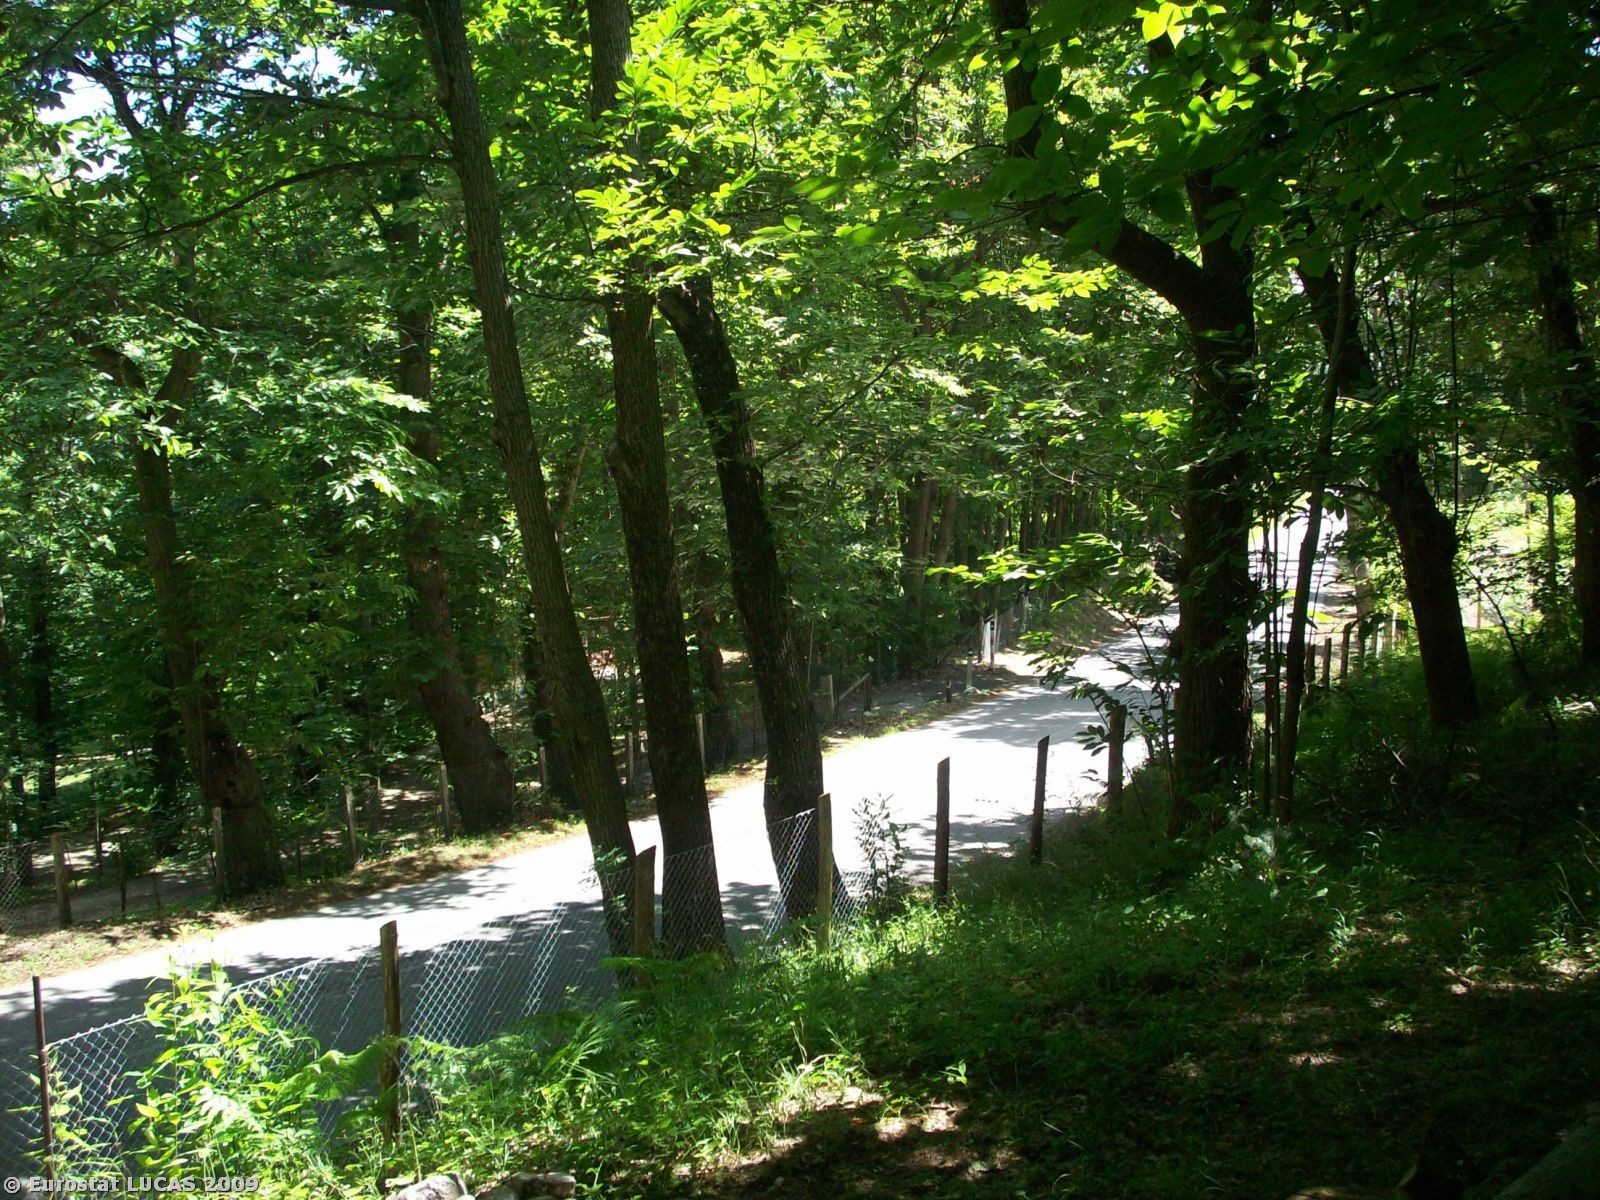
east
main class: Artificial land
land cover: Non built-up linear features
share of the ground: > 75 %
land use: Road transport
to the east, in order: Broadleaved woodland; Fences; Shruby margins; Paved roads, cycling and walking lanes; Shruby margins; Fences; Broadleaved woodland; Grassland with sparse tree/shrub cover
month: July
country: IT
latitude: 40.0260
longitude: 15.7515
